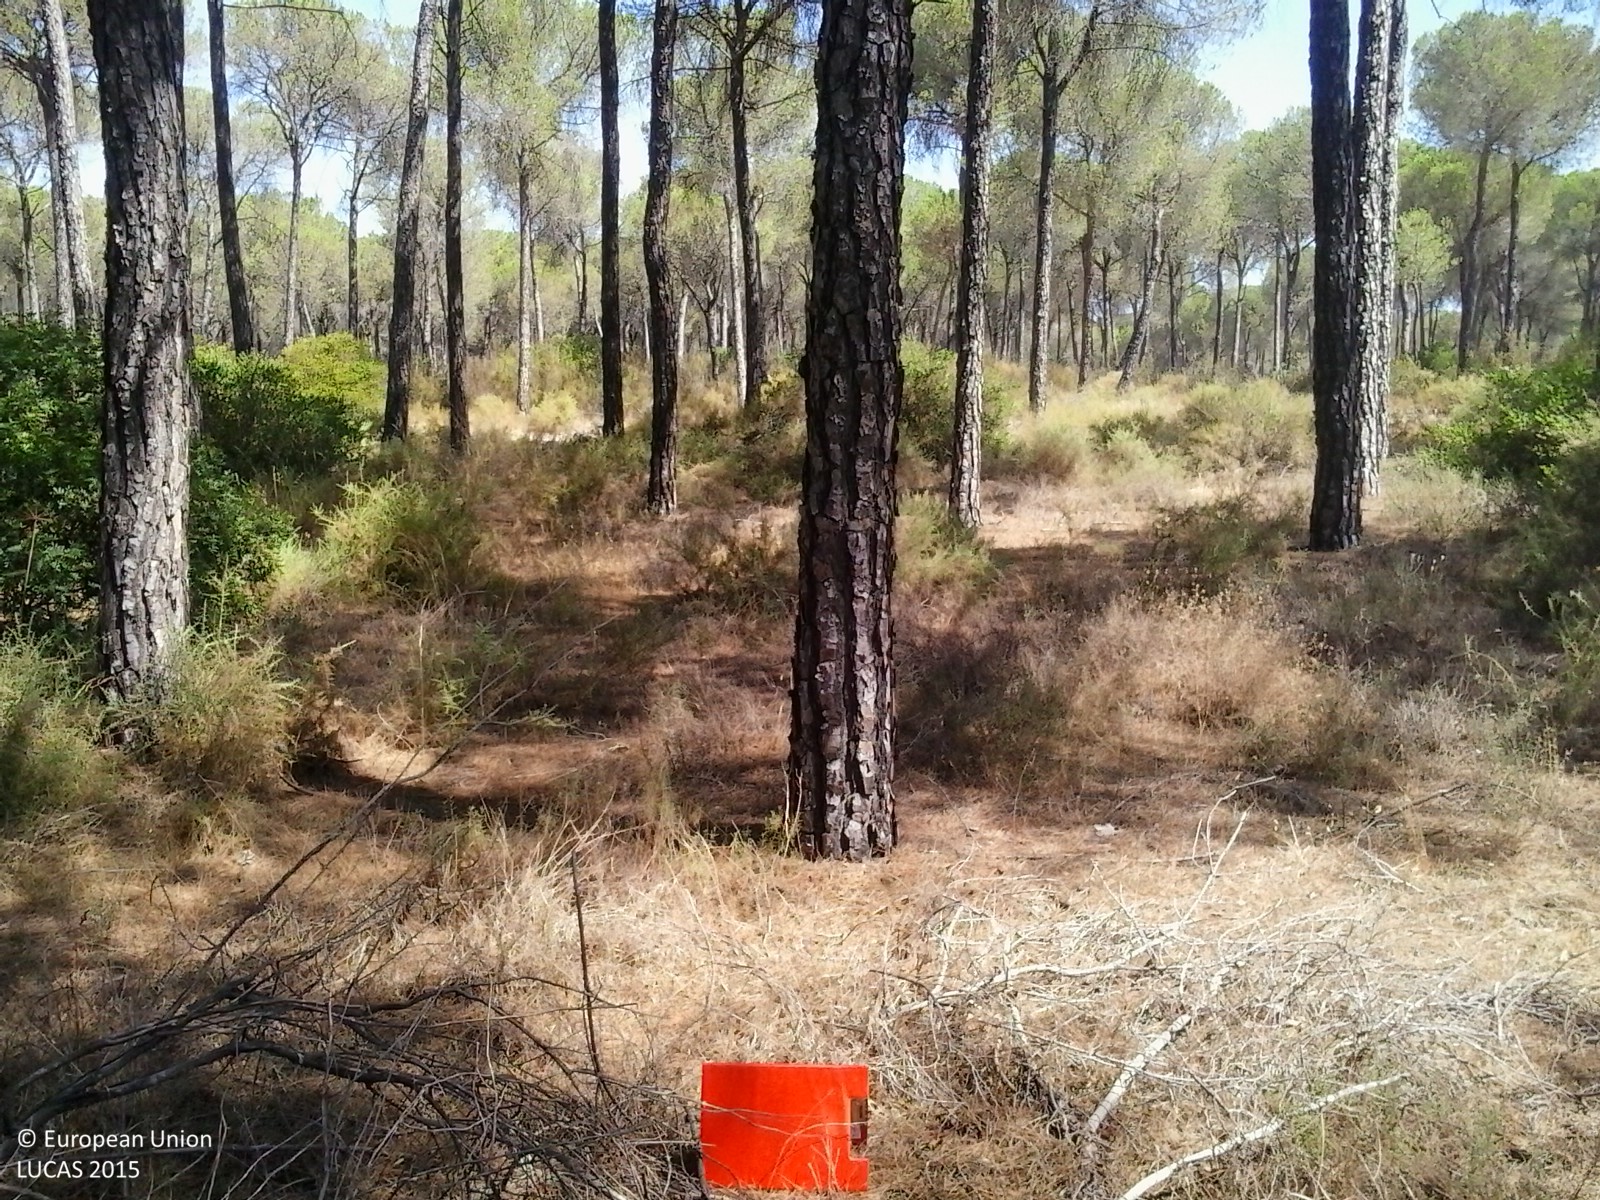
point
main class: Woodland
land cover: Pine dominated coniferous woodland
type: coniferous forest of the mediterranean region
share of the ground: > 75 %
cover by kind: coniferous forest trees 75 %, herbaceous plants 15 %, shrubs 10 %
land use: Forestry
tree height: > 5 m
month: July
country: ES
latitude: 37.2388
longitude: -6.3836
